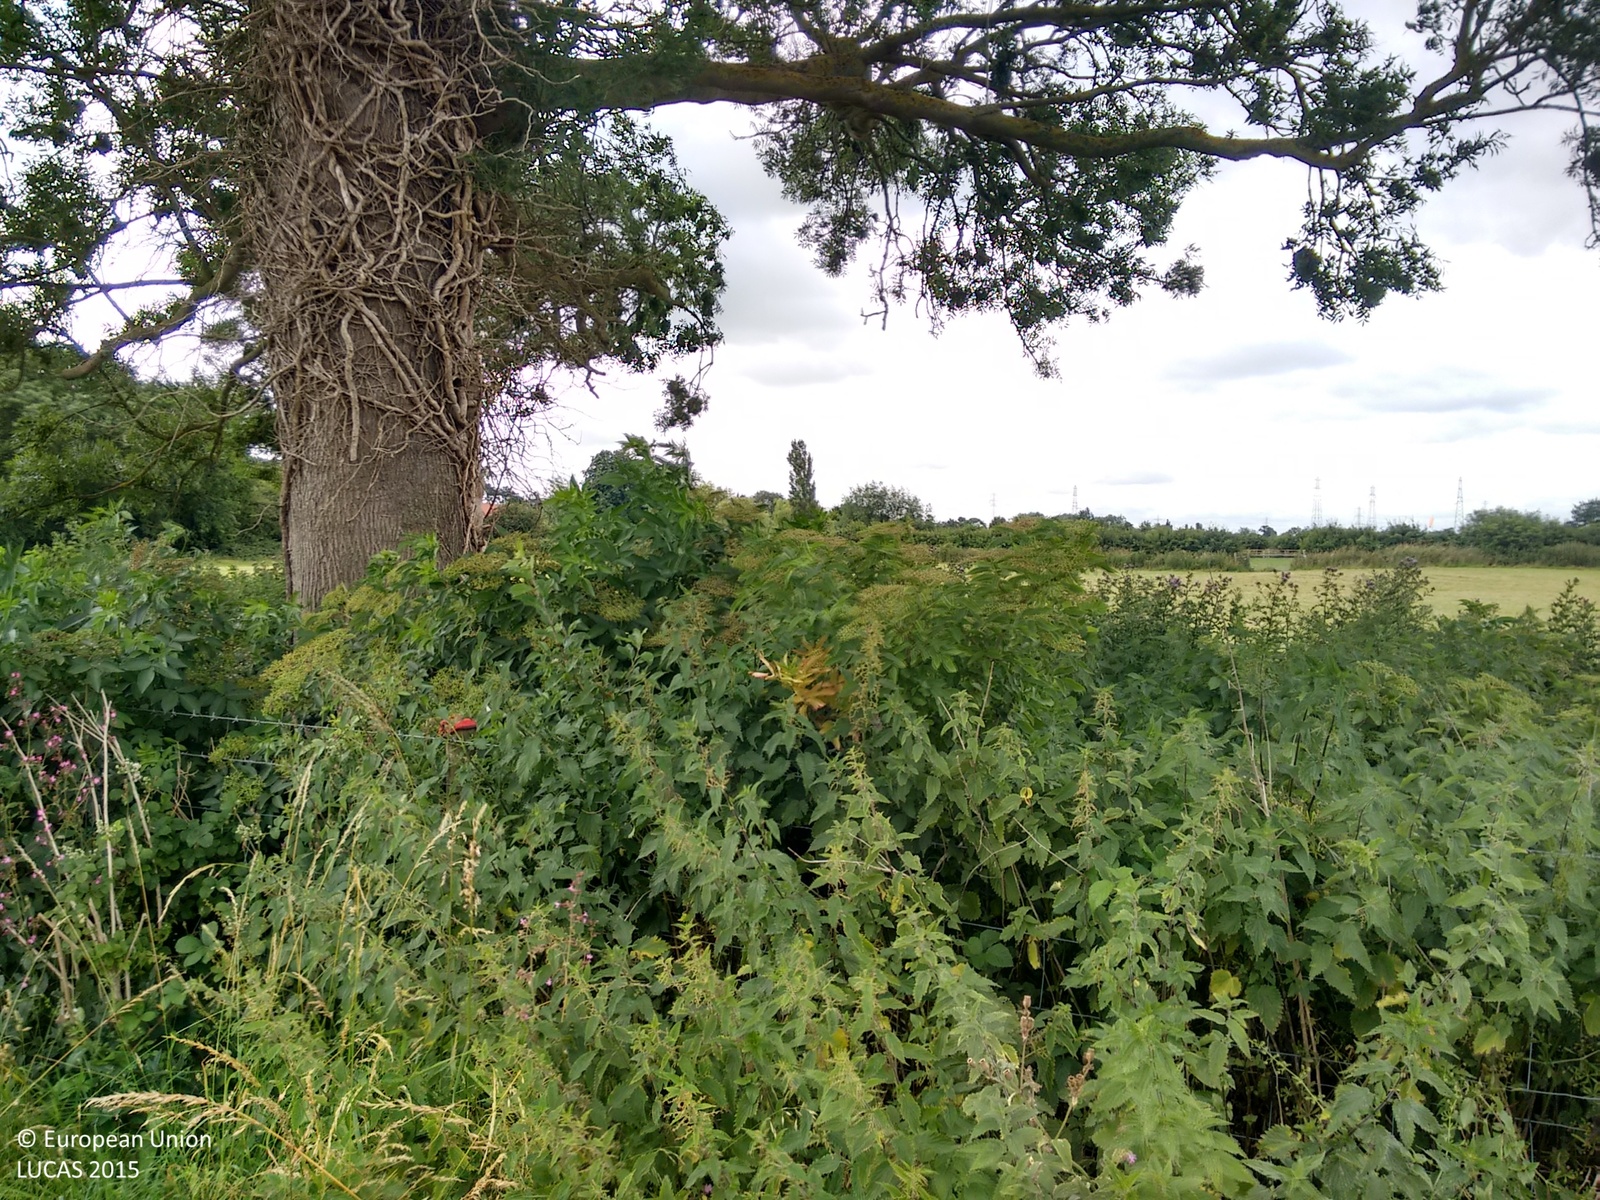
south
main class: Grassland
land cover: Grassland without tree/shrub cover
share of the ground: > 75 %
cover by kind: herbaceous plants 100 %
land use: Agriculture (excluding fallow land and kitchen gardens)
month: July
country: GB
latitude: 53.0572
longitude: -0.8593
